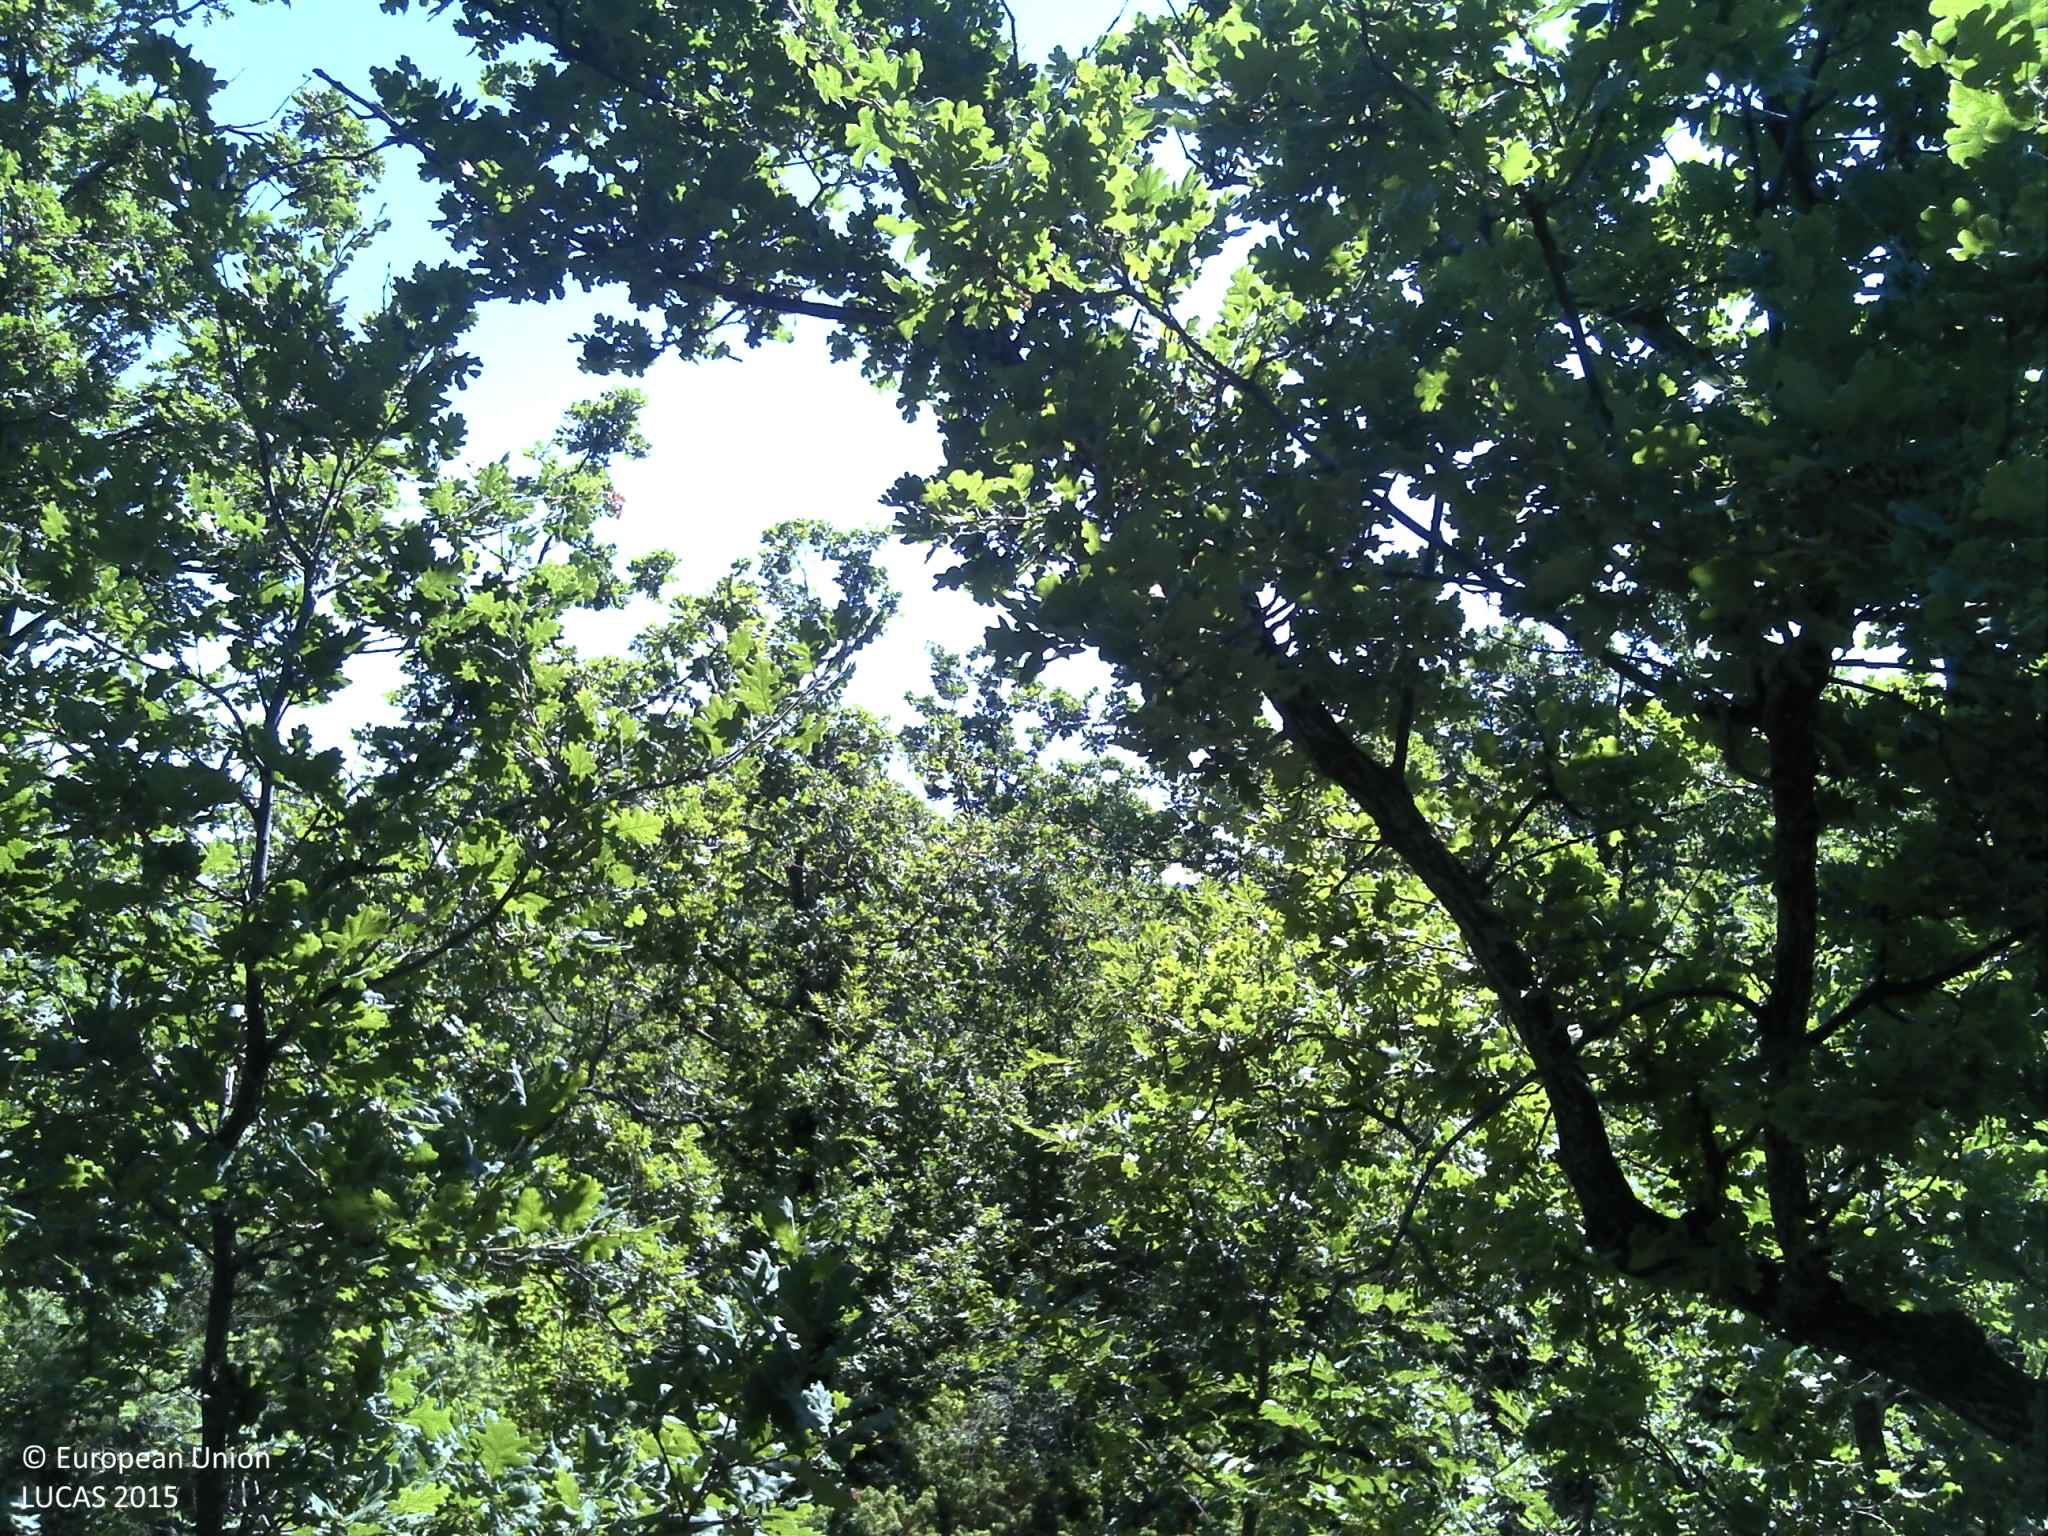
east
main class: Woodland
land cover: Broadleaved woodland
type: thermophilous deciduous forest
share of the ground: > 75 %
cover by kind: broadleaved forest trees 80 %, consolidated bare surface 10 %, herbaceous plants 5 %, unconsolidated bare surface 5 %
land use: Semi-natural and natural areas not in use
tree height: > 5 m
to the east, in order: Broadleaved woodland; Dry stone walls; Broadleaved woodland; Dry stone walls; Broadleaved woodland; Dry stone walls; Shrubland with sparse tree cover; Broadleaved woodland
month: June
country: HR
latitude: 43.5594
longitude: 16.0442
